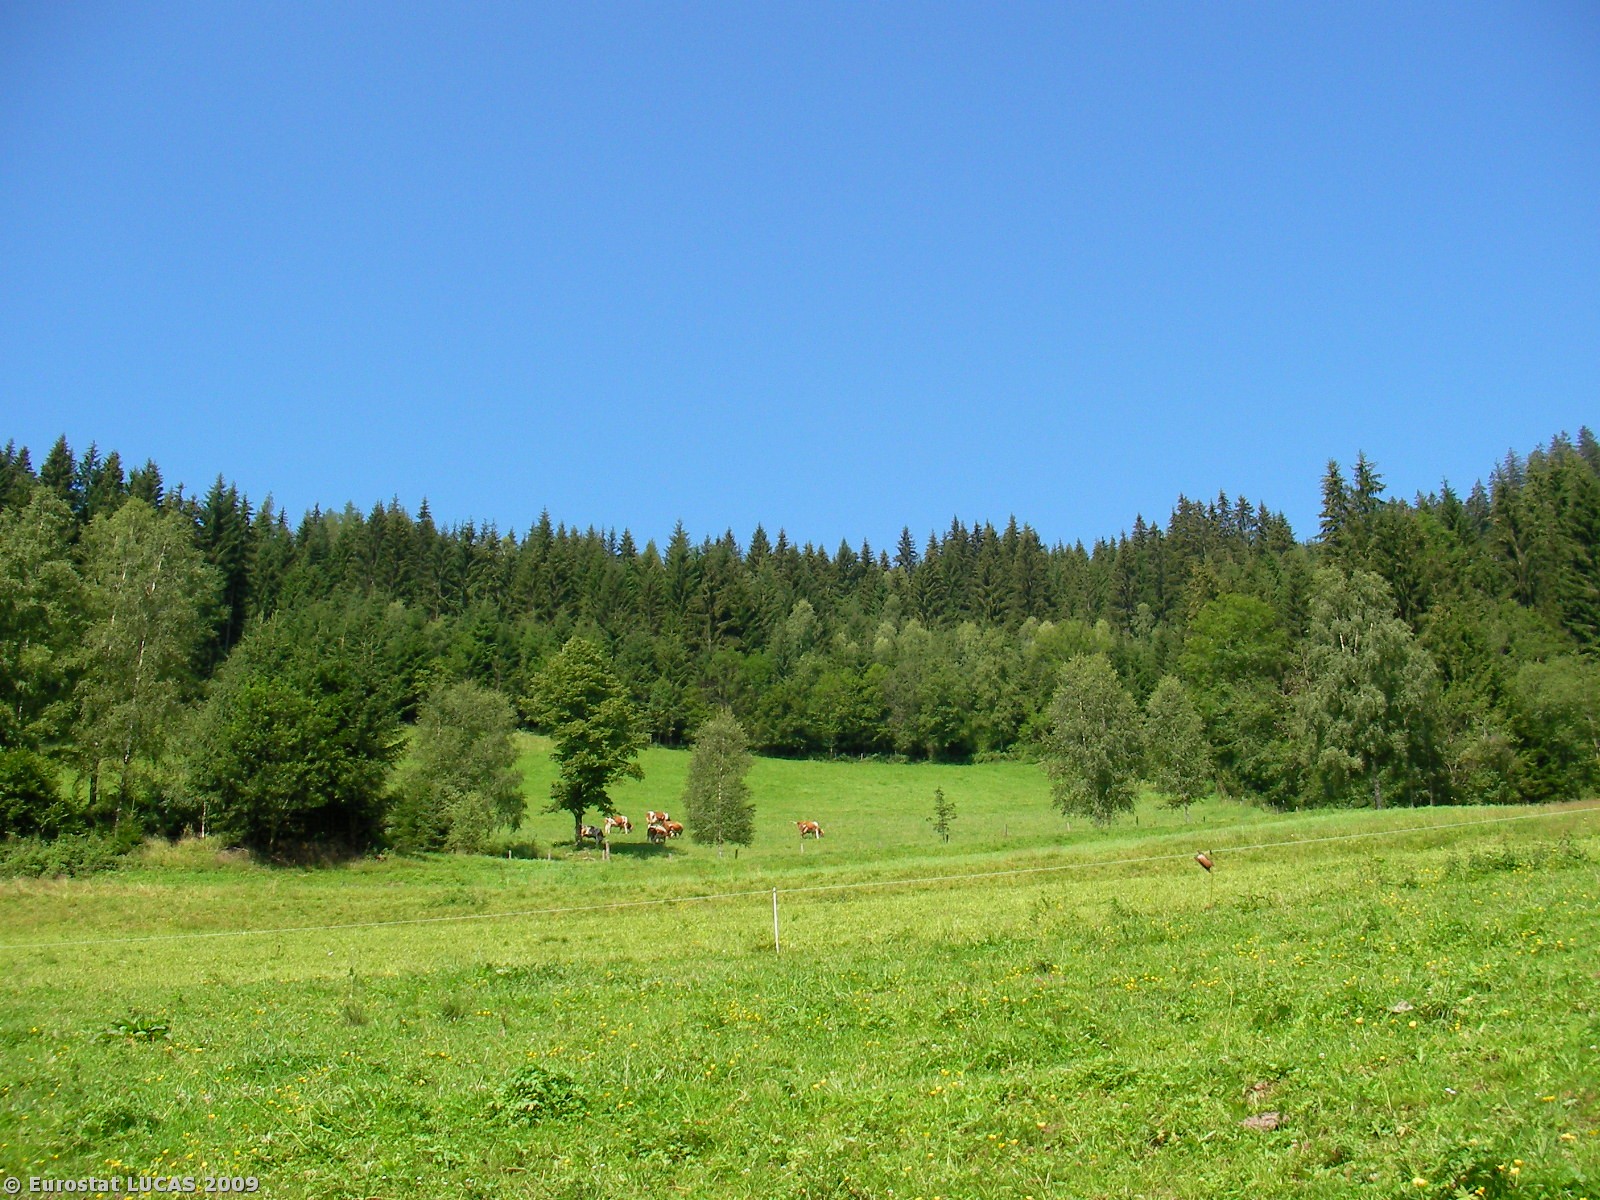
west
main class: Grassland
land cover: Grassland without tree/shrub cover
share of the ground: > 75 %
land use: Agriculture (excluding fallow land and kitchen gardens)
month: July
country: AT
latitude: 47.6273
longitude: 15.6572
